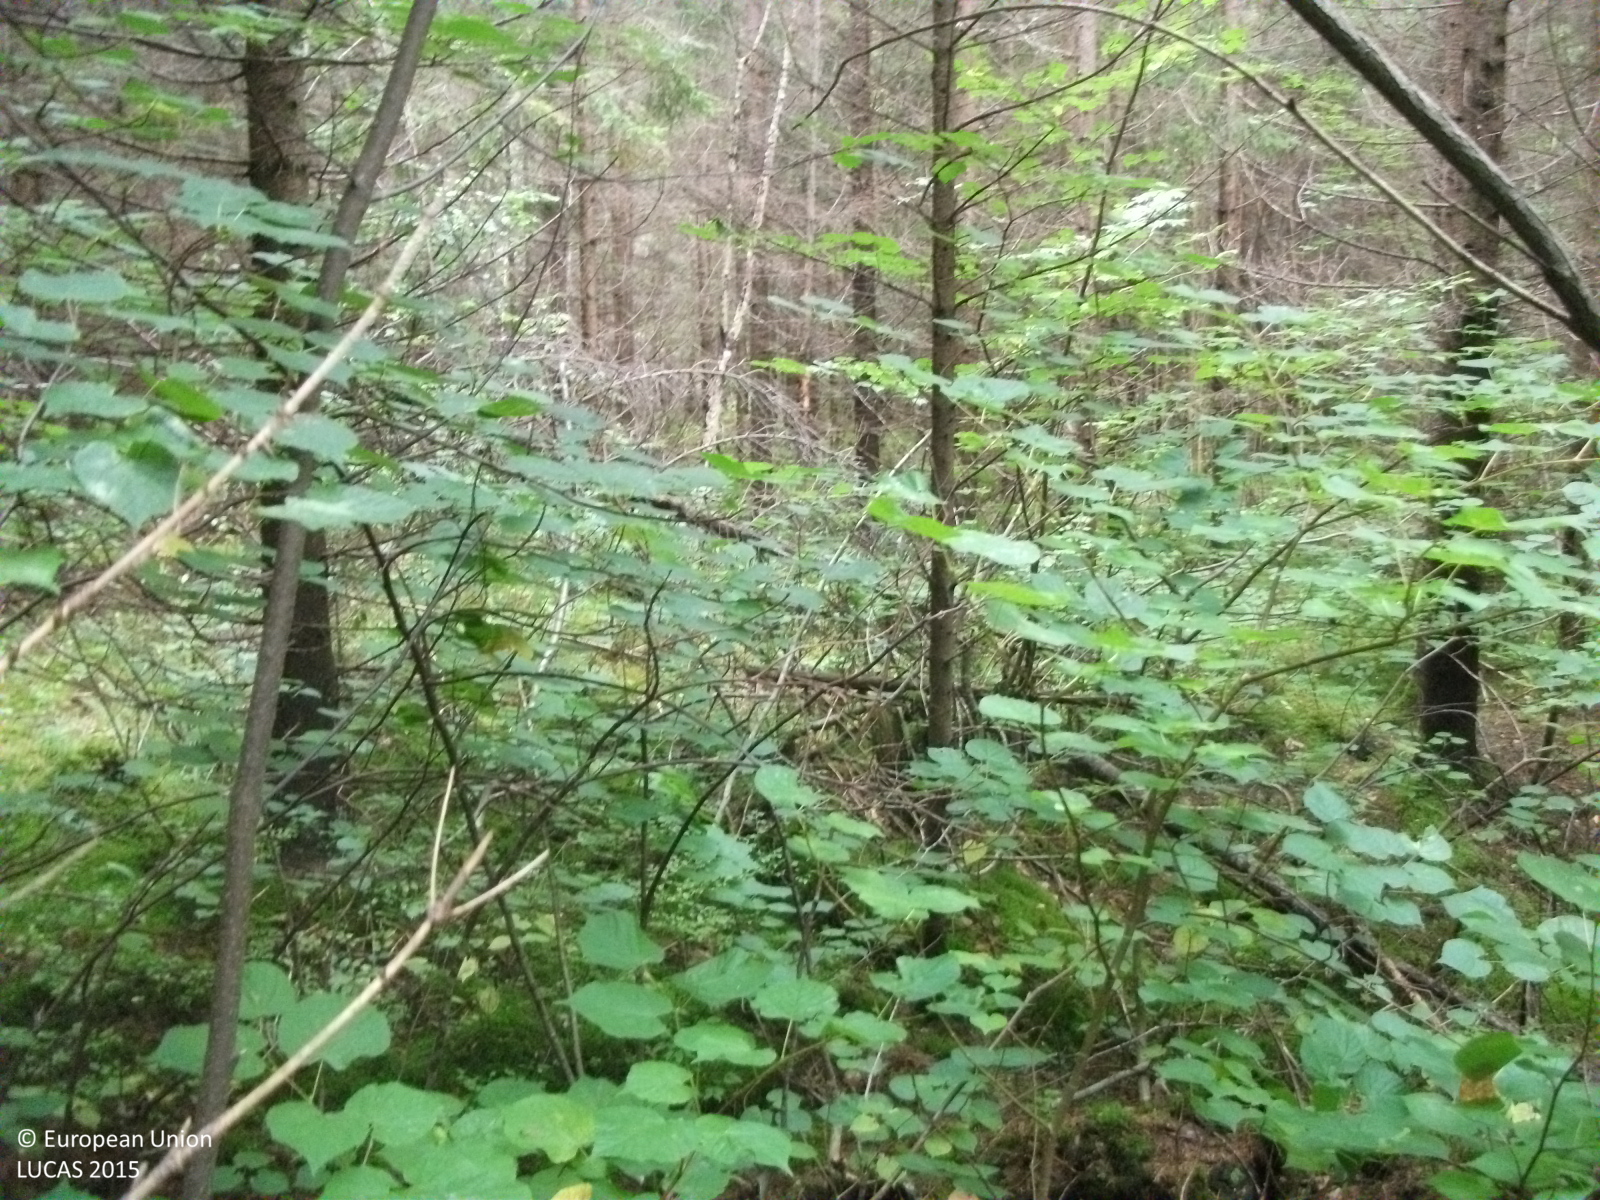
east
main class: Woodland
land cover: Spruce dominated coniferous woodland
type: hemiboreal forest and nemoral coniferous forest and mixed broadleaved-coniferous forest
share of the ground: > 75 %
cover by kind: coniferous forest trees 90 %, broadleaved forest trees 5 %, shrubs 5 %
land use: Forestry
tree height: > 5 m
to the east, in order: Spruce dominated coniferous woodland; Other mixed woodland; Broadleaved woodland
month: September
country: LV
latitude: 57.6034
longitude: 24.3962
